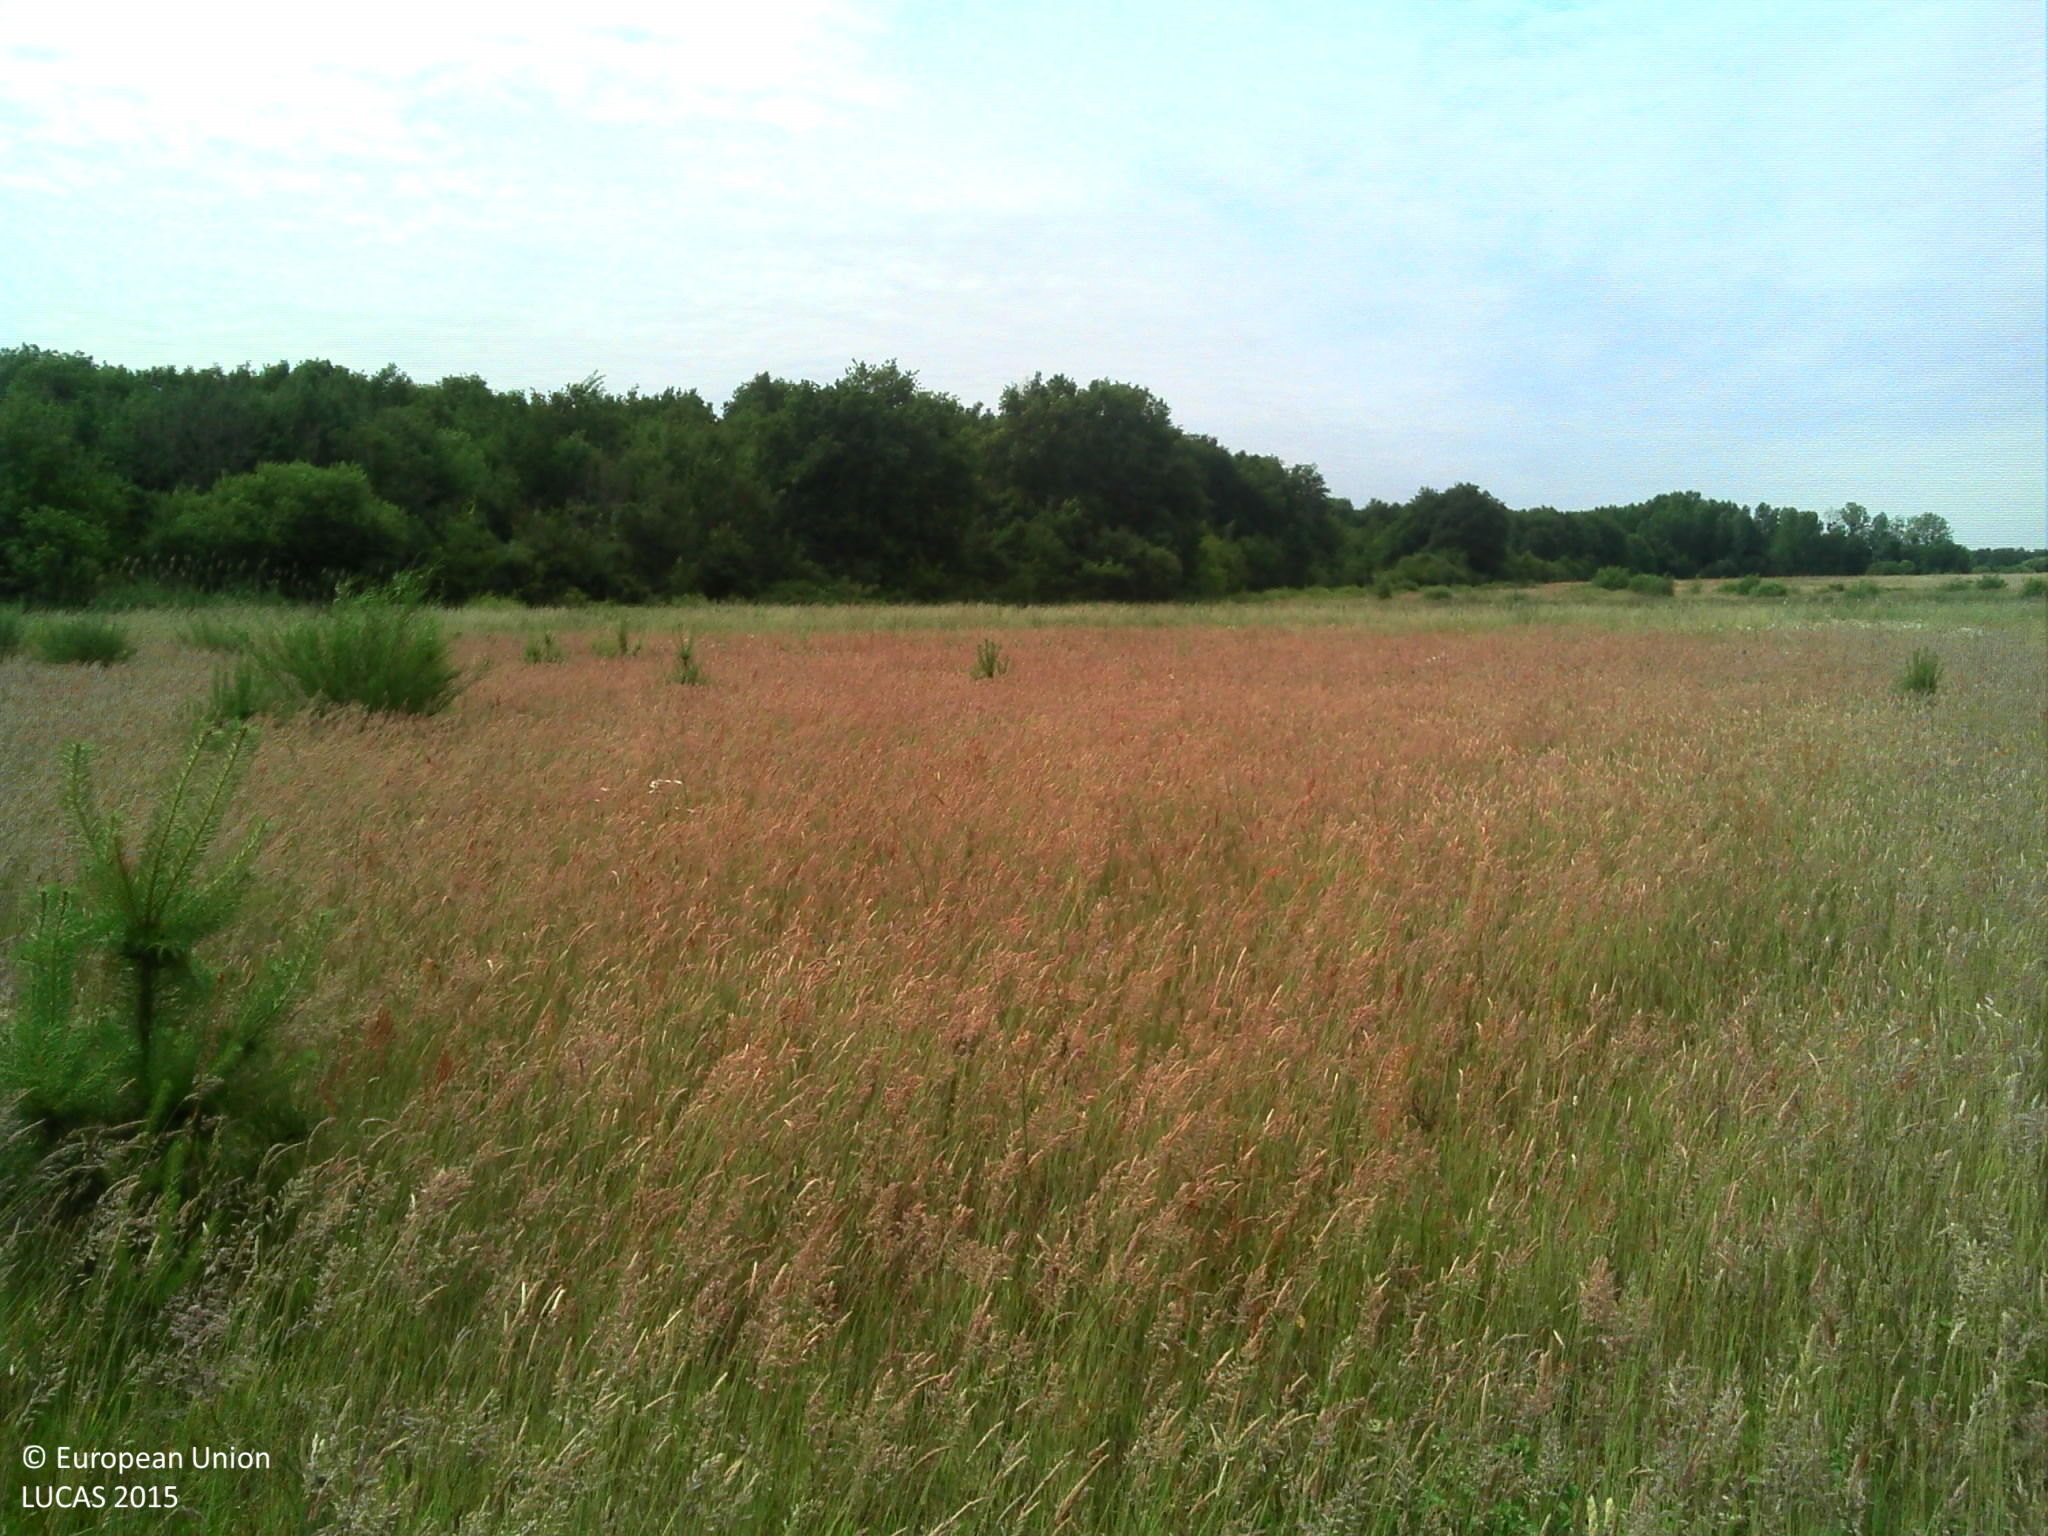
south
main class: Grassland
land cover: Grassland without tree/shrub cover
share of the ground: > 75 %
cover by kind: herbaceous plants 95 %, shrubs 5 %
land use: Agriculture (excluding fallow land and kitchen gardens)
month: June
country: FR
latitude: 47.4455
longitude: 1.5390
